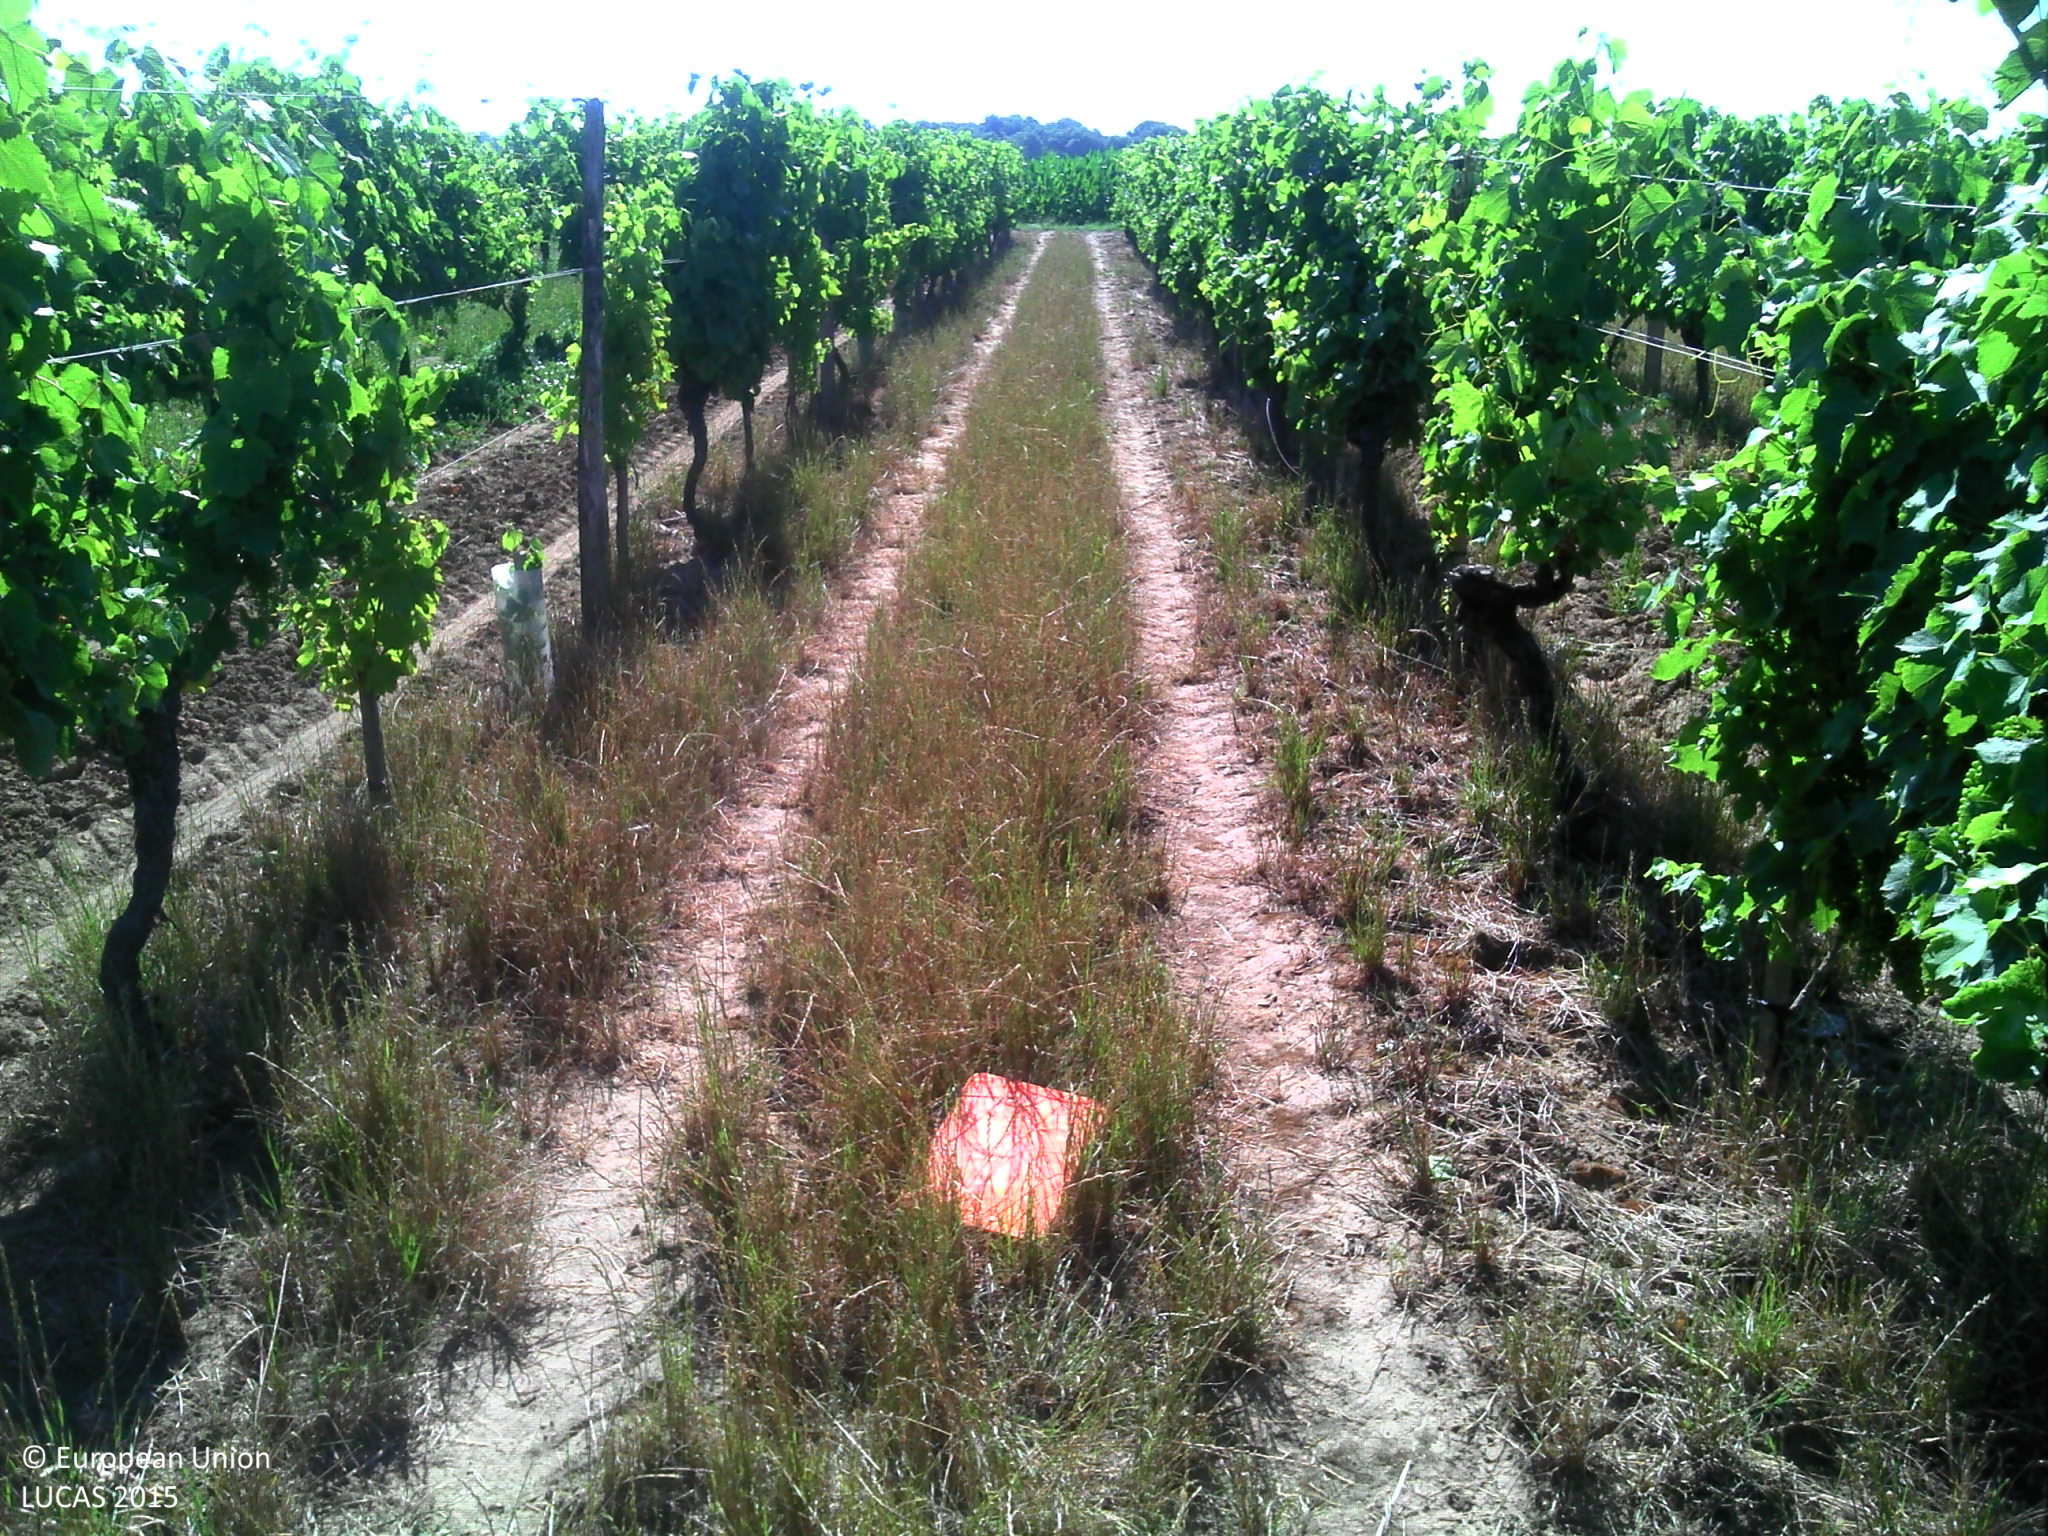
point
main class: Cropland
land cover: Vineyards
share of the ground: 25 - 50 %
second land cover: Grassland without tree/shrub cover
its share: 50 - 75 %
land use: Agriculture (excluding fallow land and kitchen gardens)
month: June
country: FR
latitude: 45.6733
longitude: -0.8217
